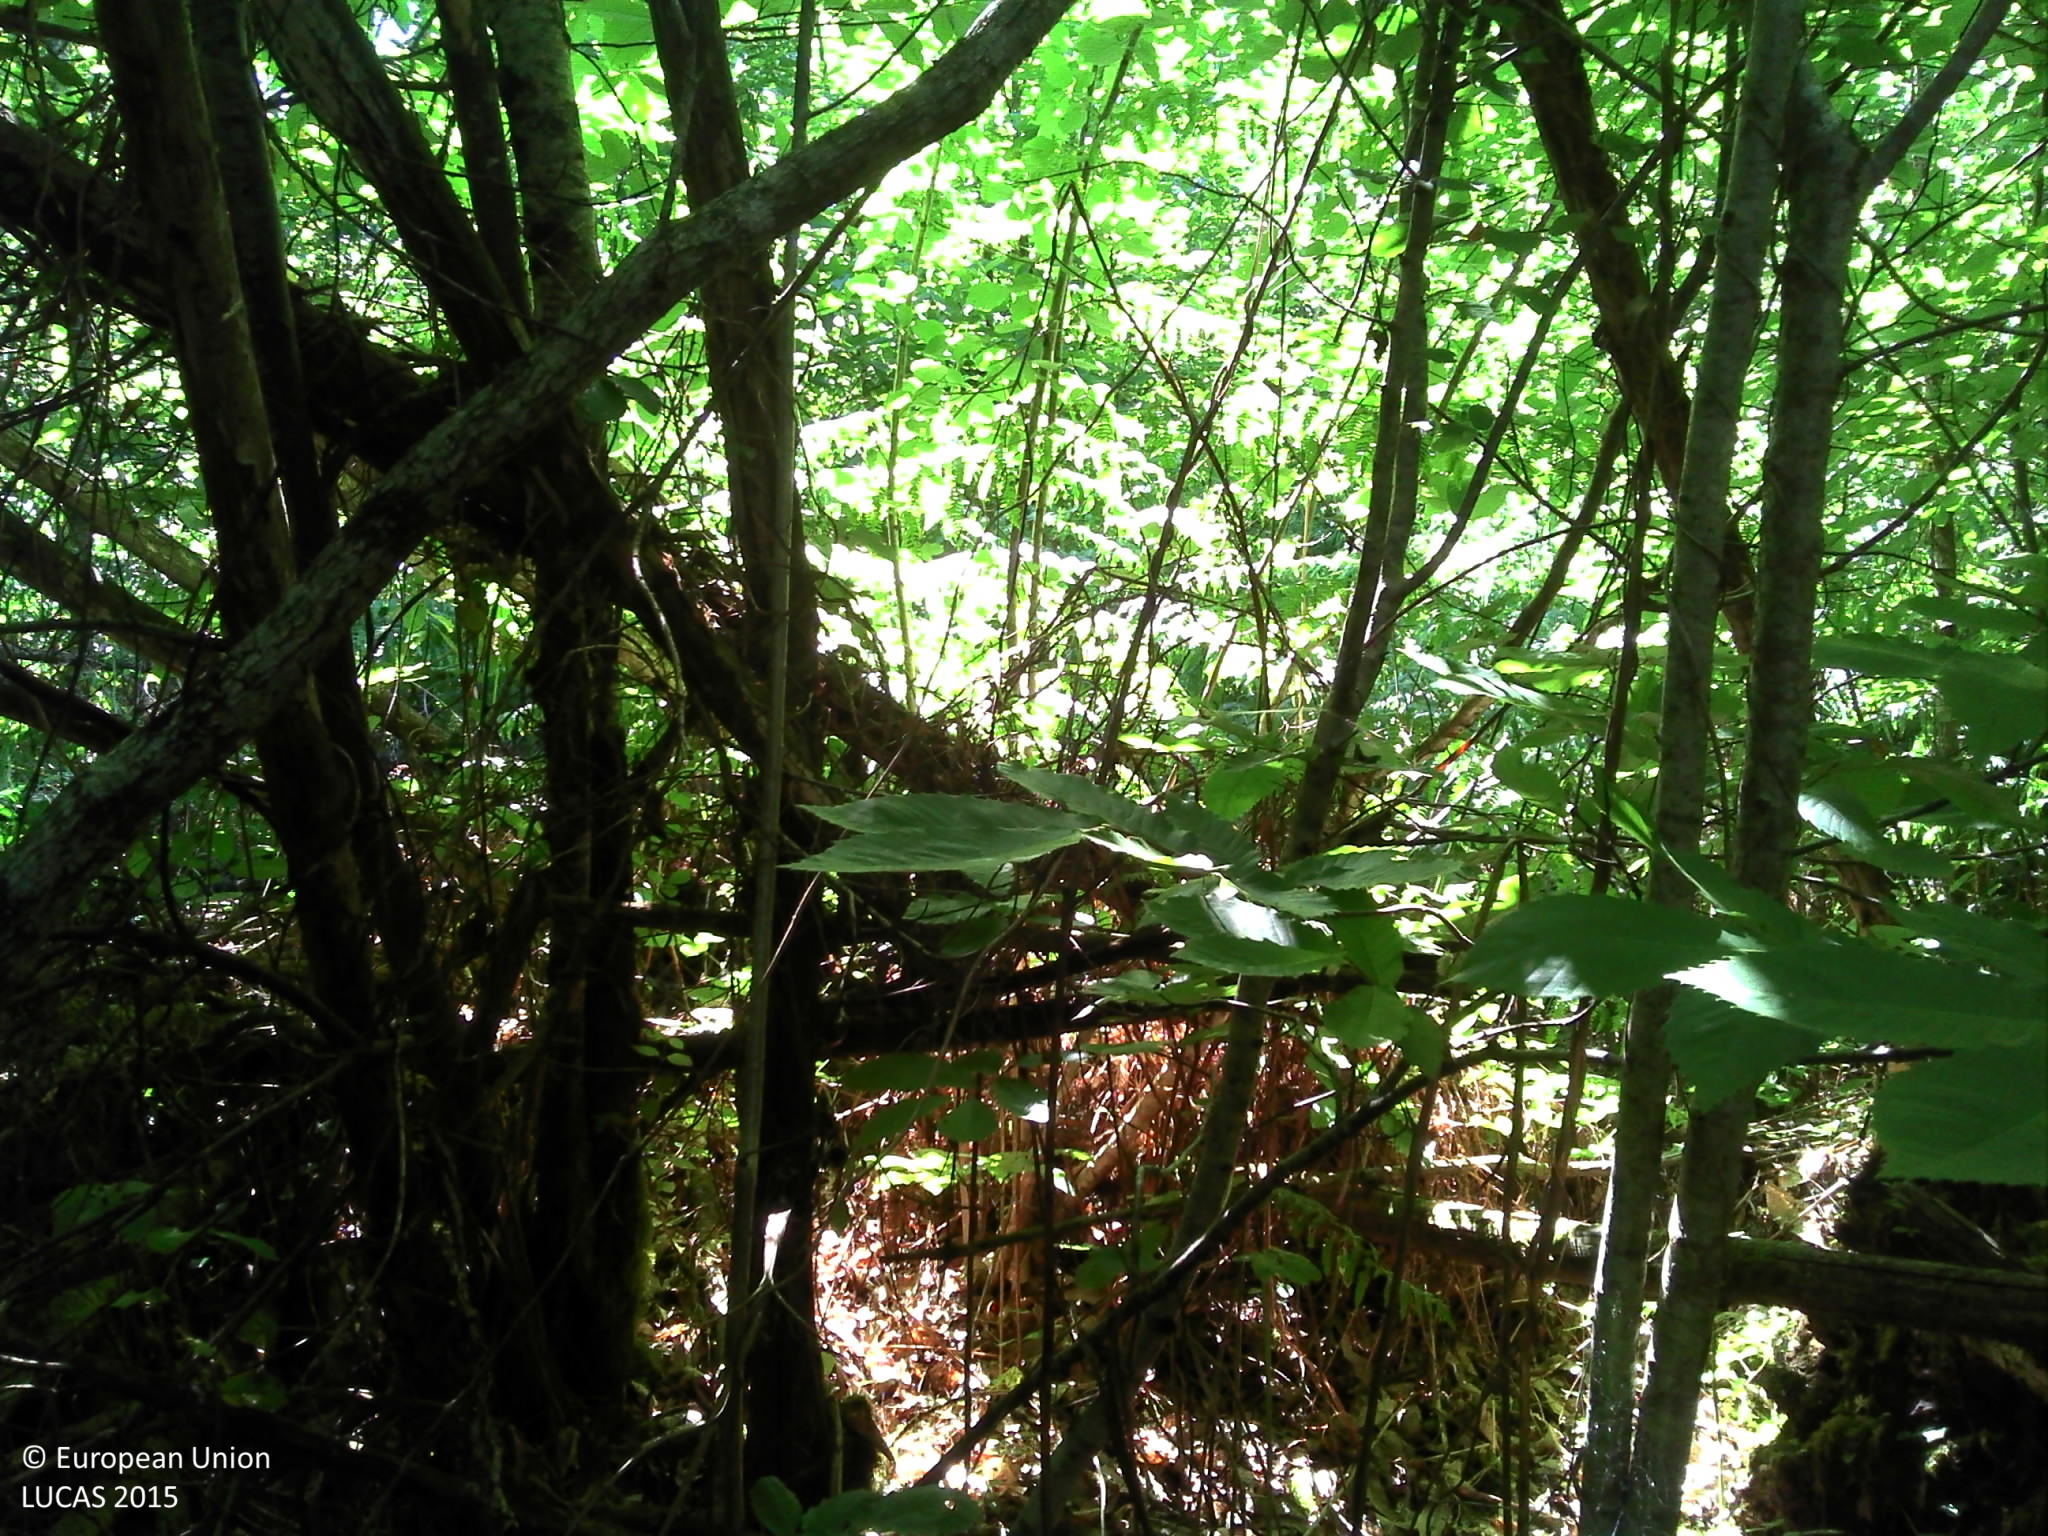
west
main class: Woodland
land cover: Broadleaved woodland
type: thermophilous deciduous forest
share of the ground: > 75 %
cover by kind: broadleaved forest trees 80 %, shrubs 15 %, herbaceous plants 5 %
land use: Semi-natural and natural areas not in use
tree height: > 5 m
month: June
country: FR
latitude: 45.7610
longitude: 0.6656
